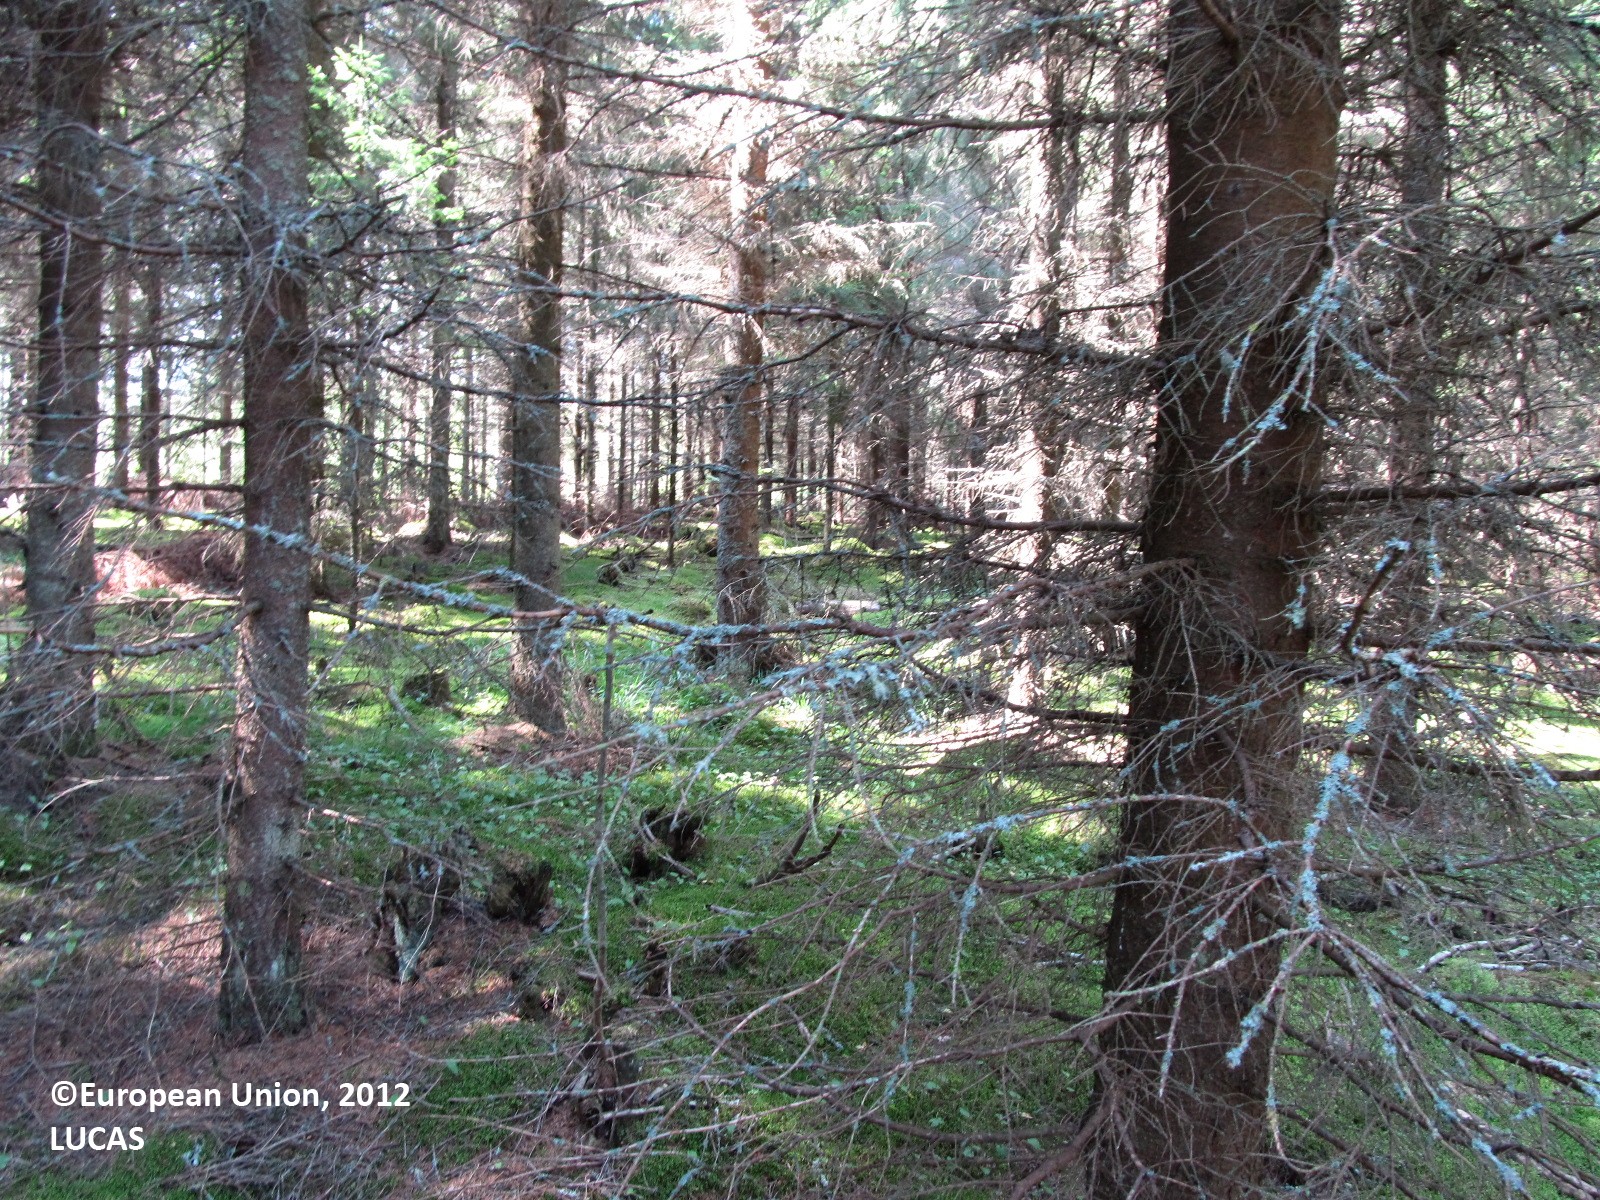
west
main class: Woodland
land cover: Spruce dominated coniferous woodland
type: boreal forest
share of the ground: 25 - 50 %
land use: Forestry
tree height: > 5 m
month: July
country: FI
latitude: 61.9828
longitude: 28.5474
